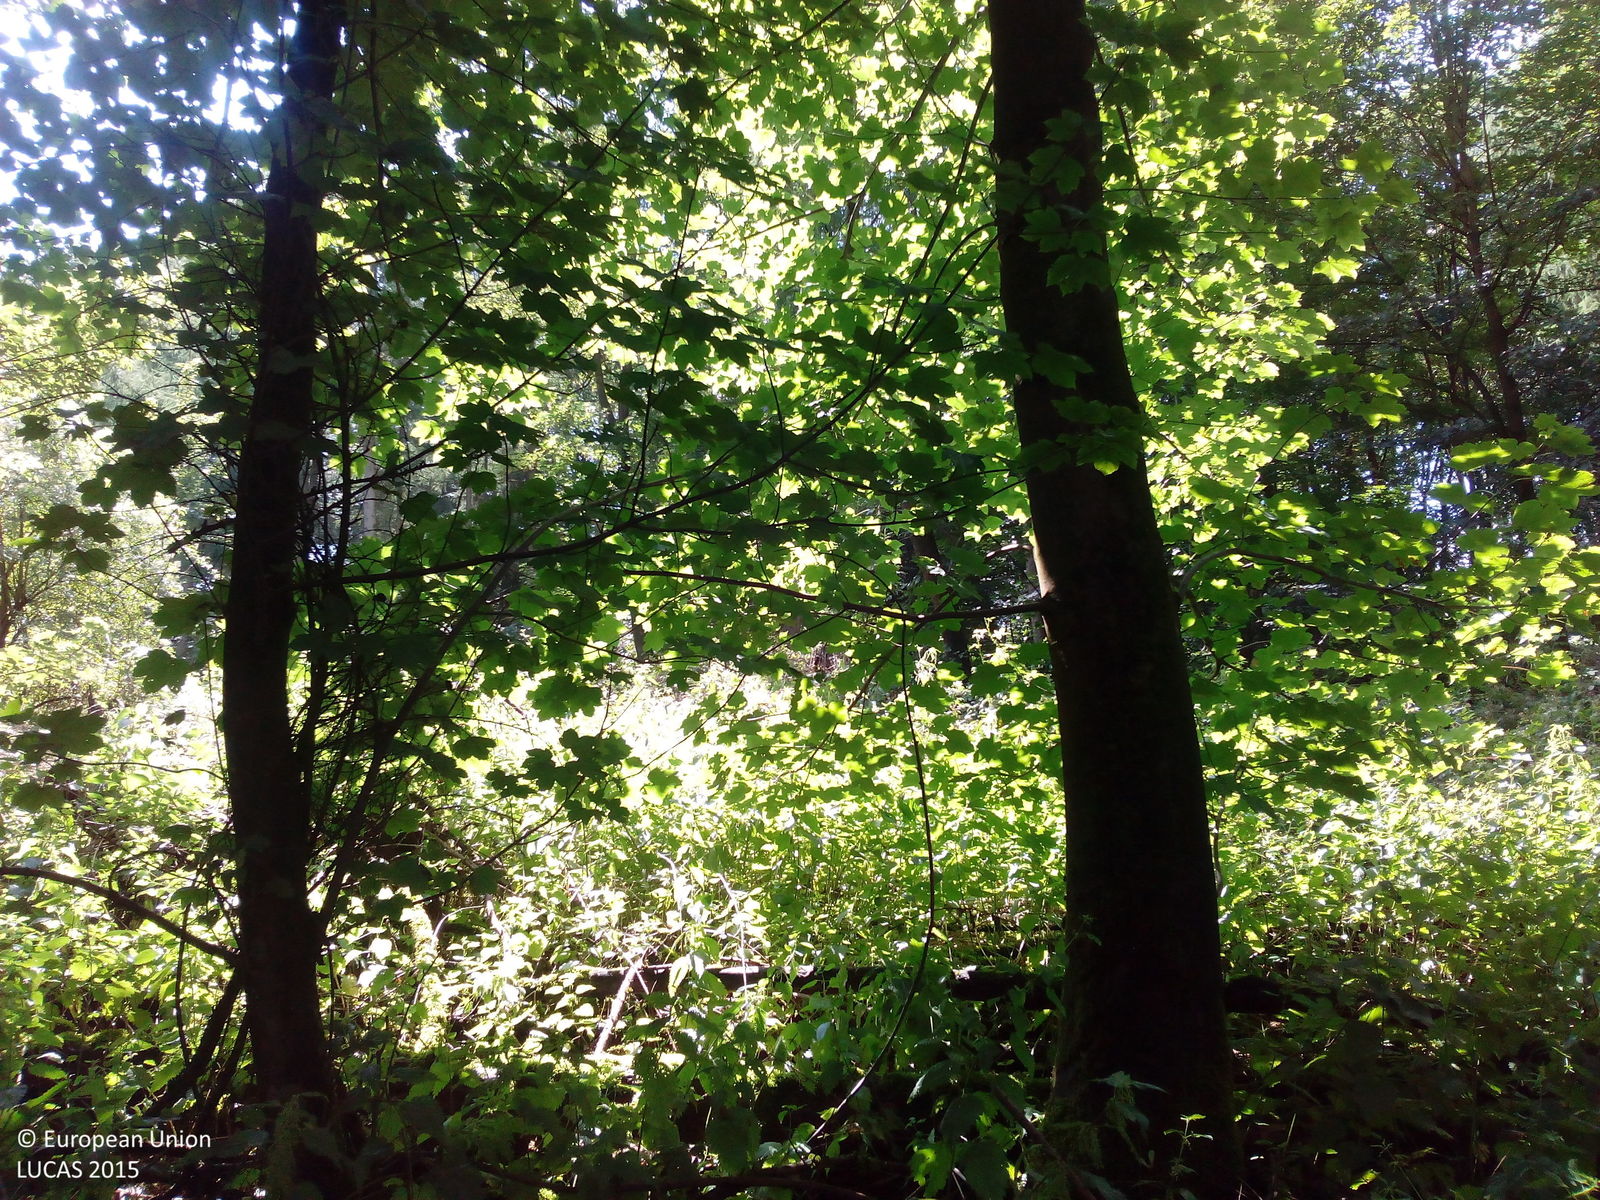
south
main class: Woodland
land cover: Broadleaved woodland
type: mesophytic deciduous forest
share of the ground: > 75 %
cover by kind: broadleaved forest trees 90 %, shrubs 5 %, herbaceous plants 5 %
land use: Forestry
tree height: > 5 m
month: July
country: DE
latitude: 52.2172
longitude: 8.0245
